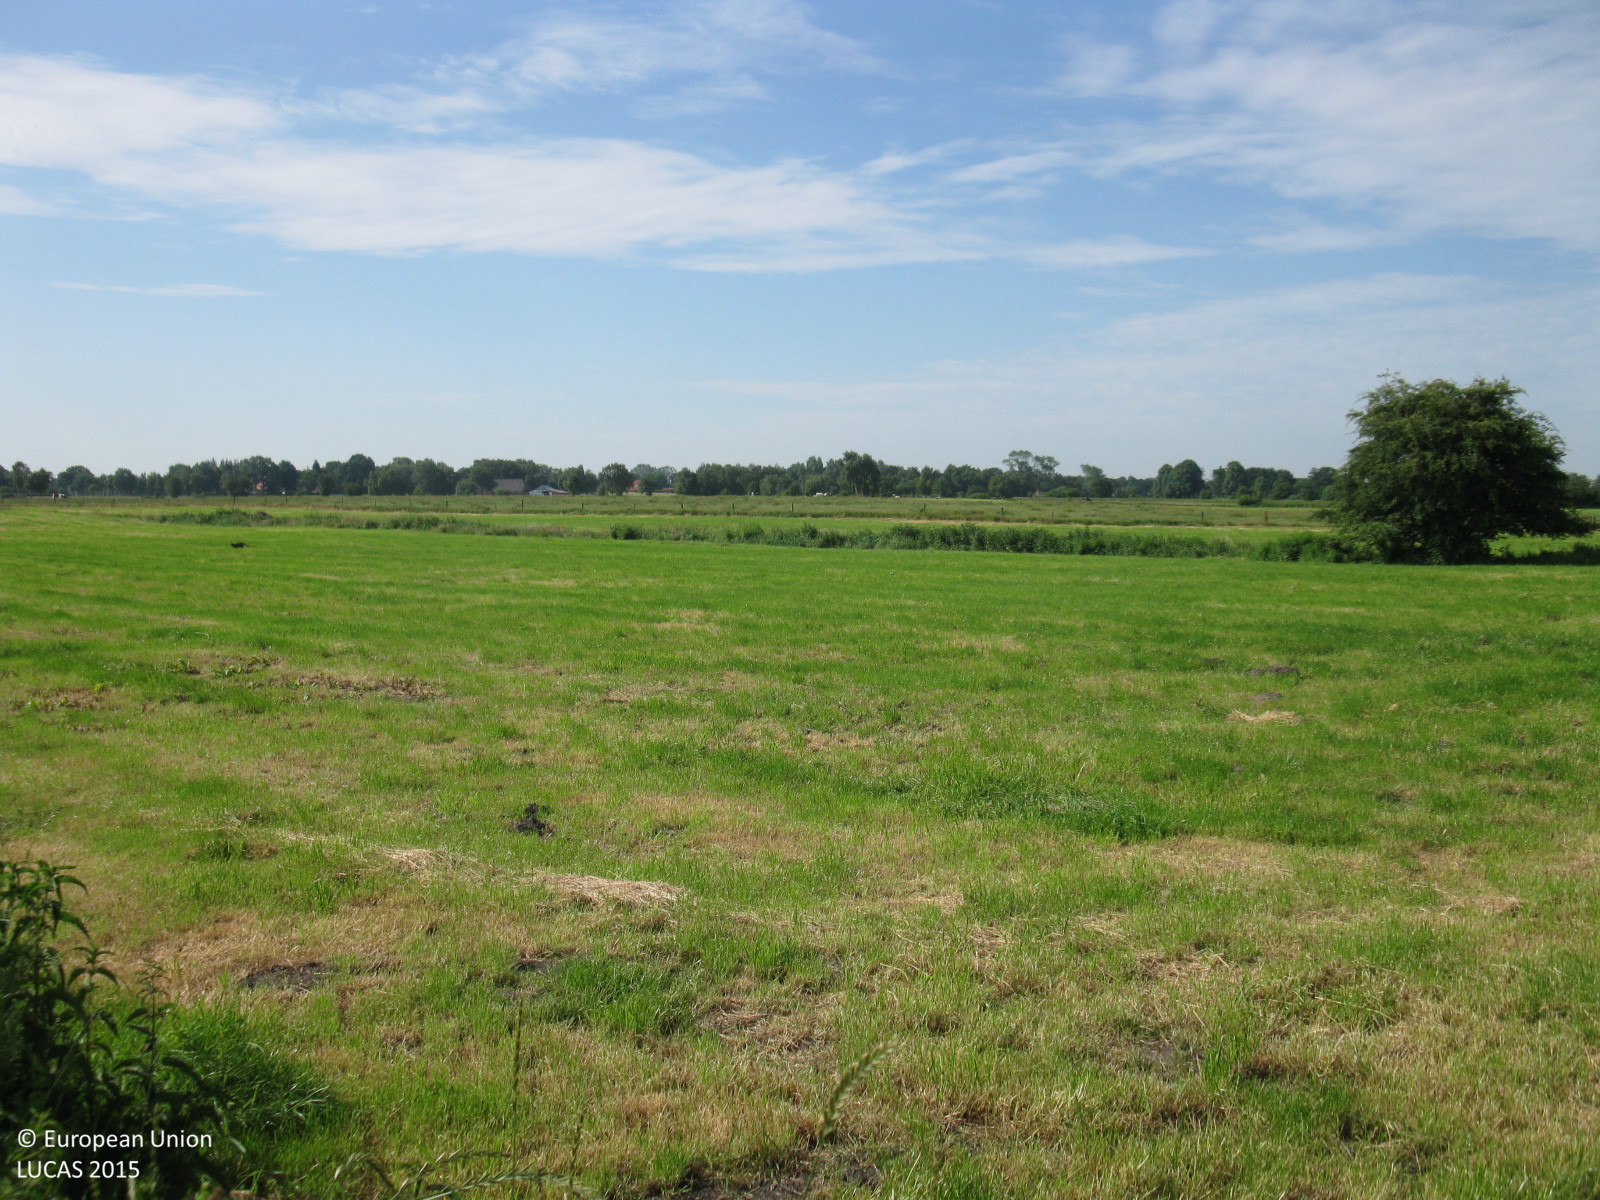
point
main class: Grassland
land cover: Grassland without tree/shrub cover
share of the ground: > 75 %
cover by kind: herbaceous plants 100 %
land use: Agriculture (excluding fallow land and kitchen gardens)
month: July
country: DE
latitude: 53.4639
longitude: 7.3948
